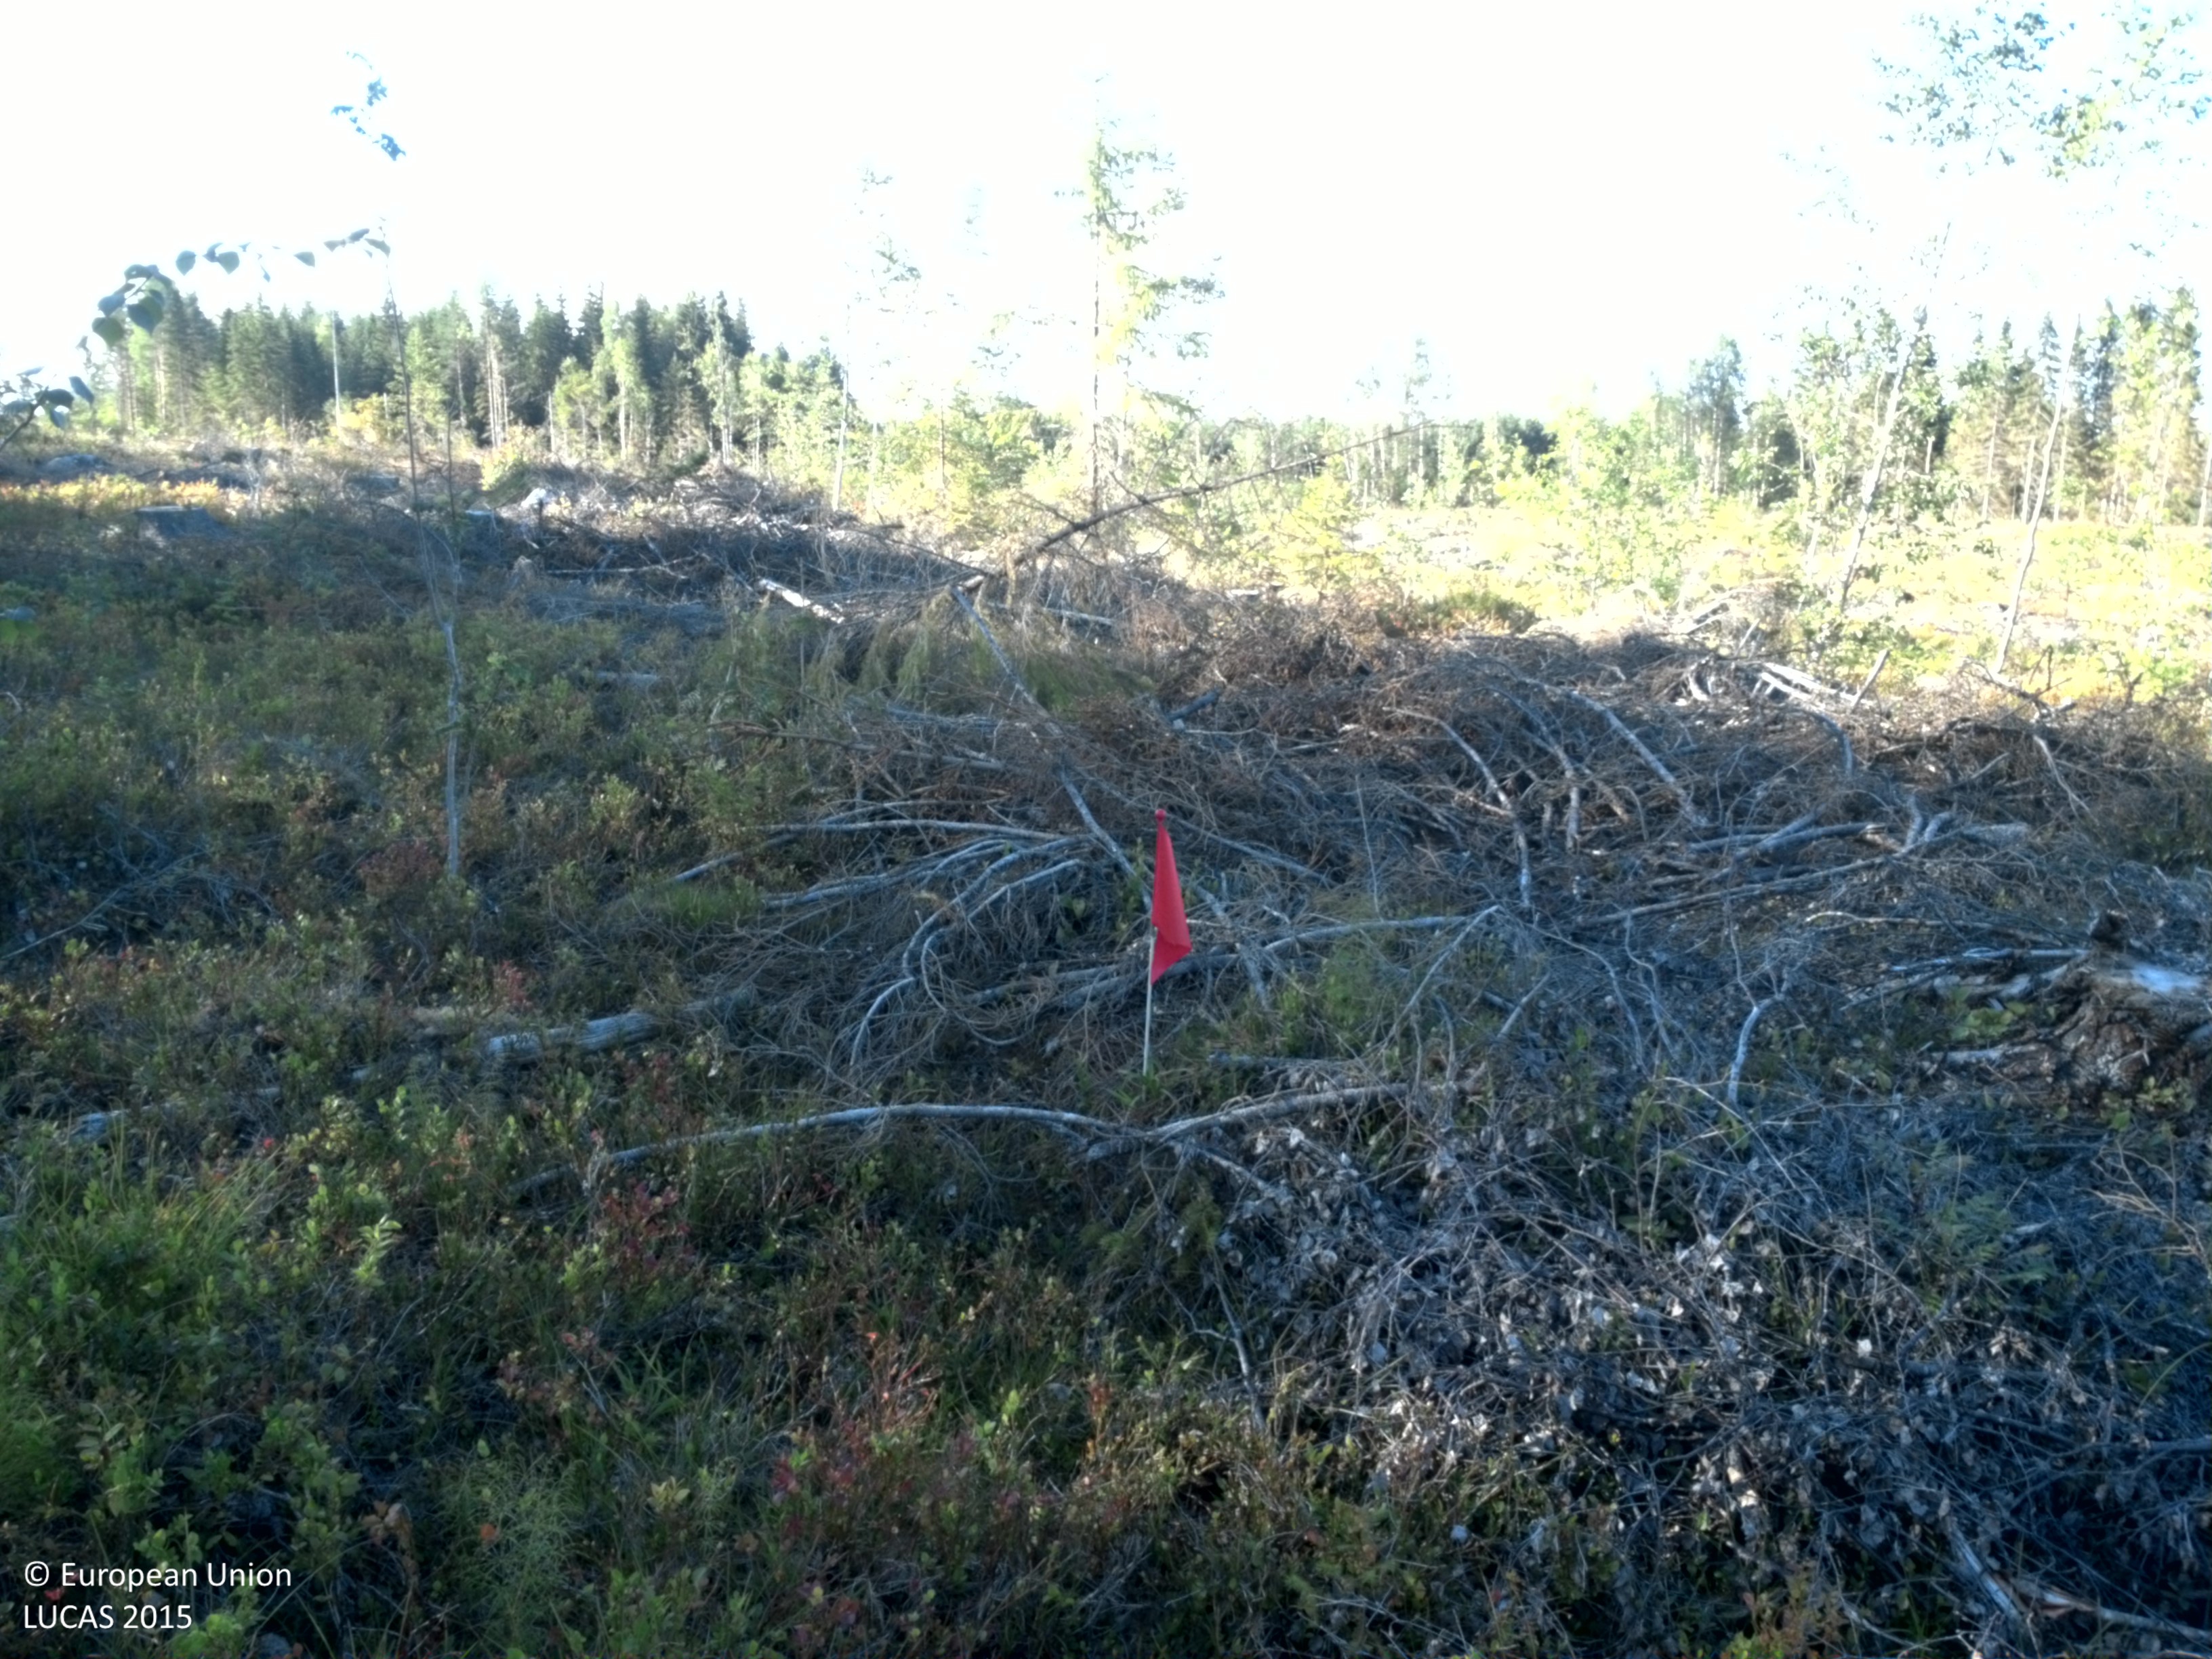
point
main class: Shrubland
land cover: Shrubland with sparse tree cover
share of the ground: > 75 %
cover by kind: shrubs 90 %, coniferous forest trees 5 %, herbaceous plants 5 %
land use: Forestry
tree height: < 5 m
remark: Clear cut
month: August
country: SE
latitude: 64.5674
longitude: 20.9364
